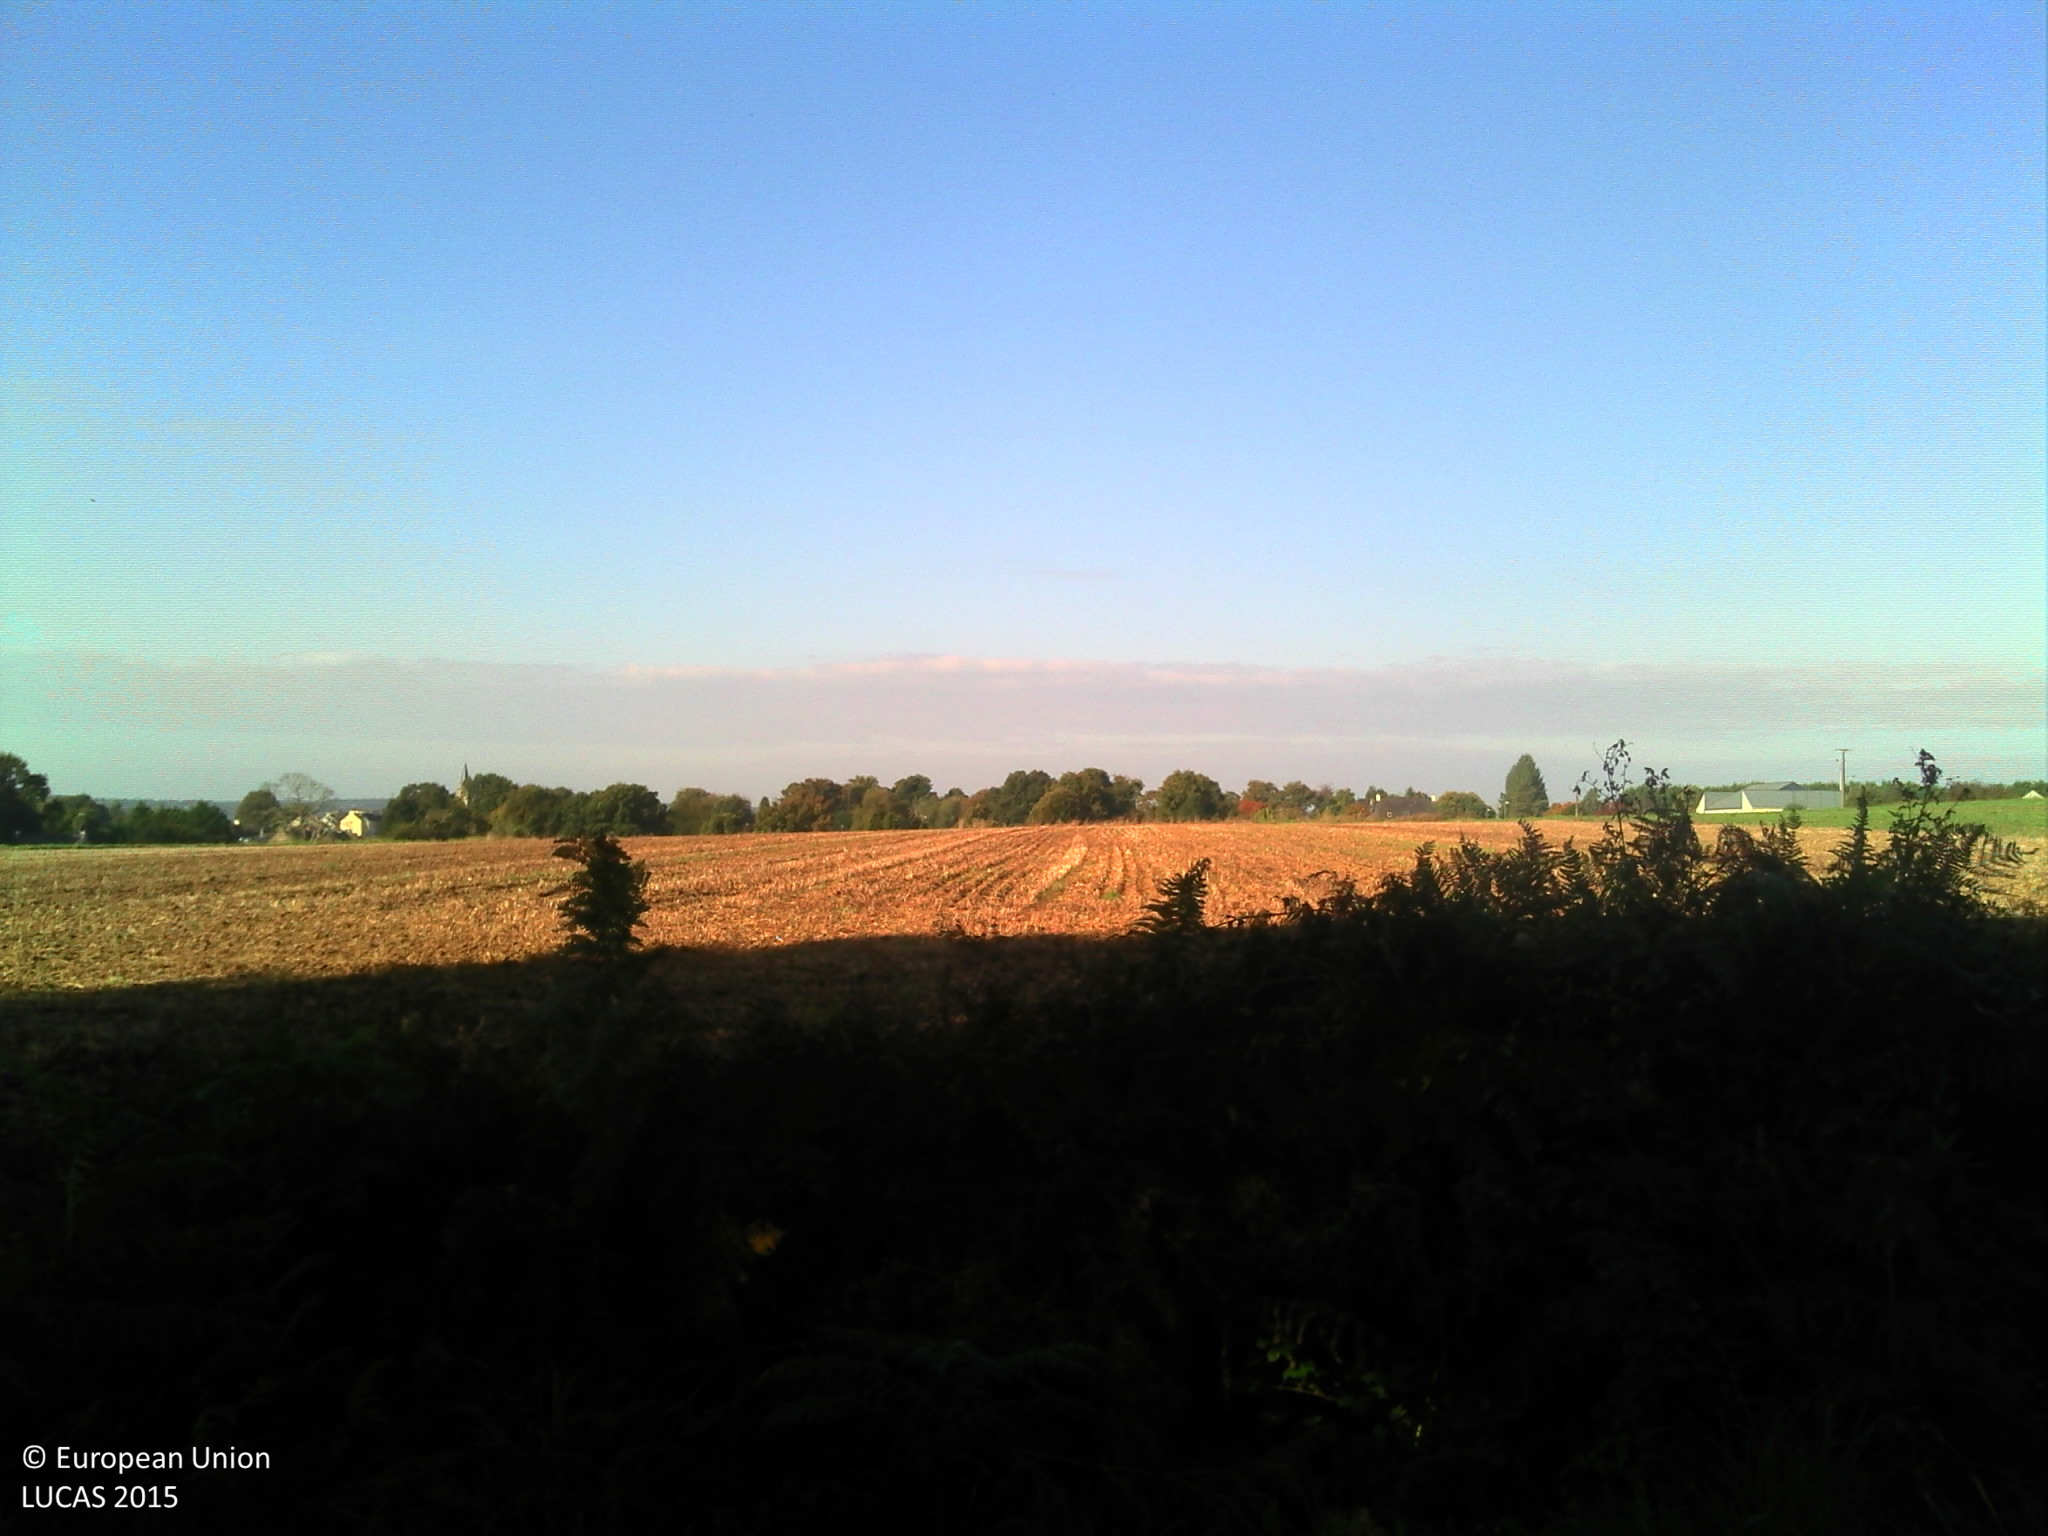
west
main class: Woodland
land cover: Broadleaved woodland
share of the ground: > 75 %
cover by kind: broadleaved forest trees 100 %
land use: Semi-natural and natural areas not in use
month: October
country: FR
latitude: 47.7428
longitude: -2.2034
